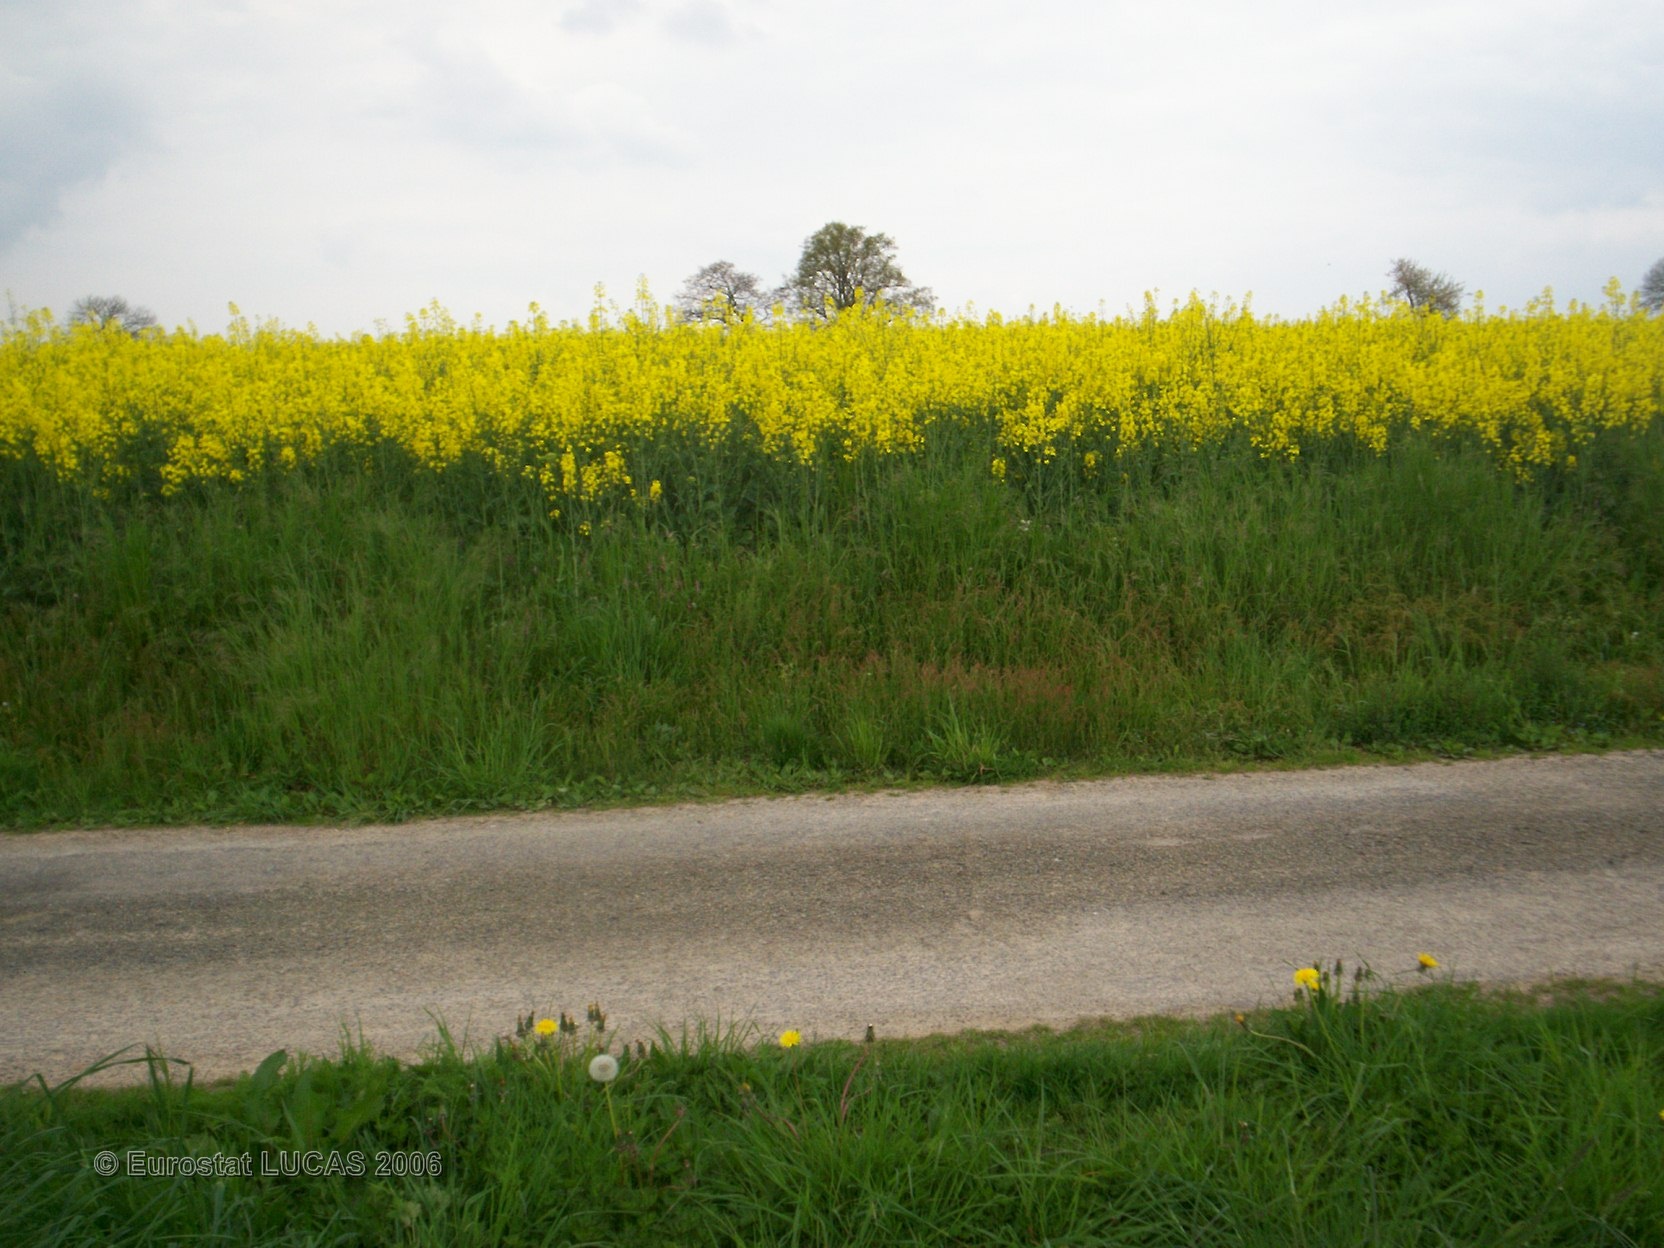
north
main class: Cropland
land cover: Maize
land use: Agriculture (excluding fallow land and kitchen gardens)
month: June
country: FR
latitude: 48.1088
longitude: -1.3388
